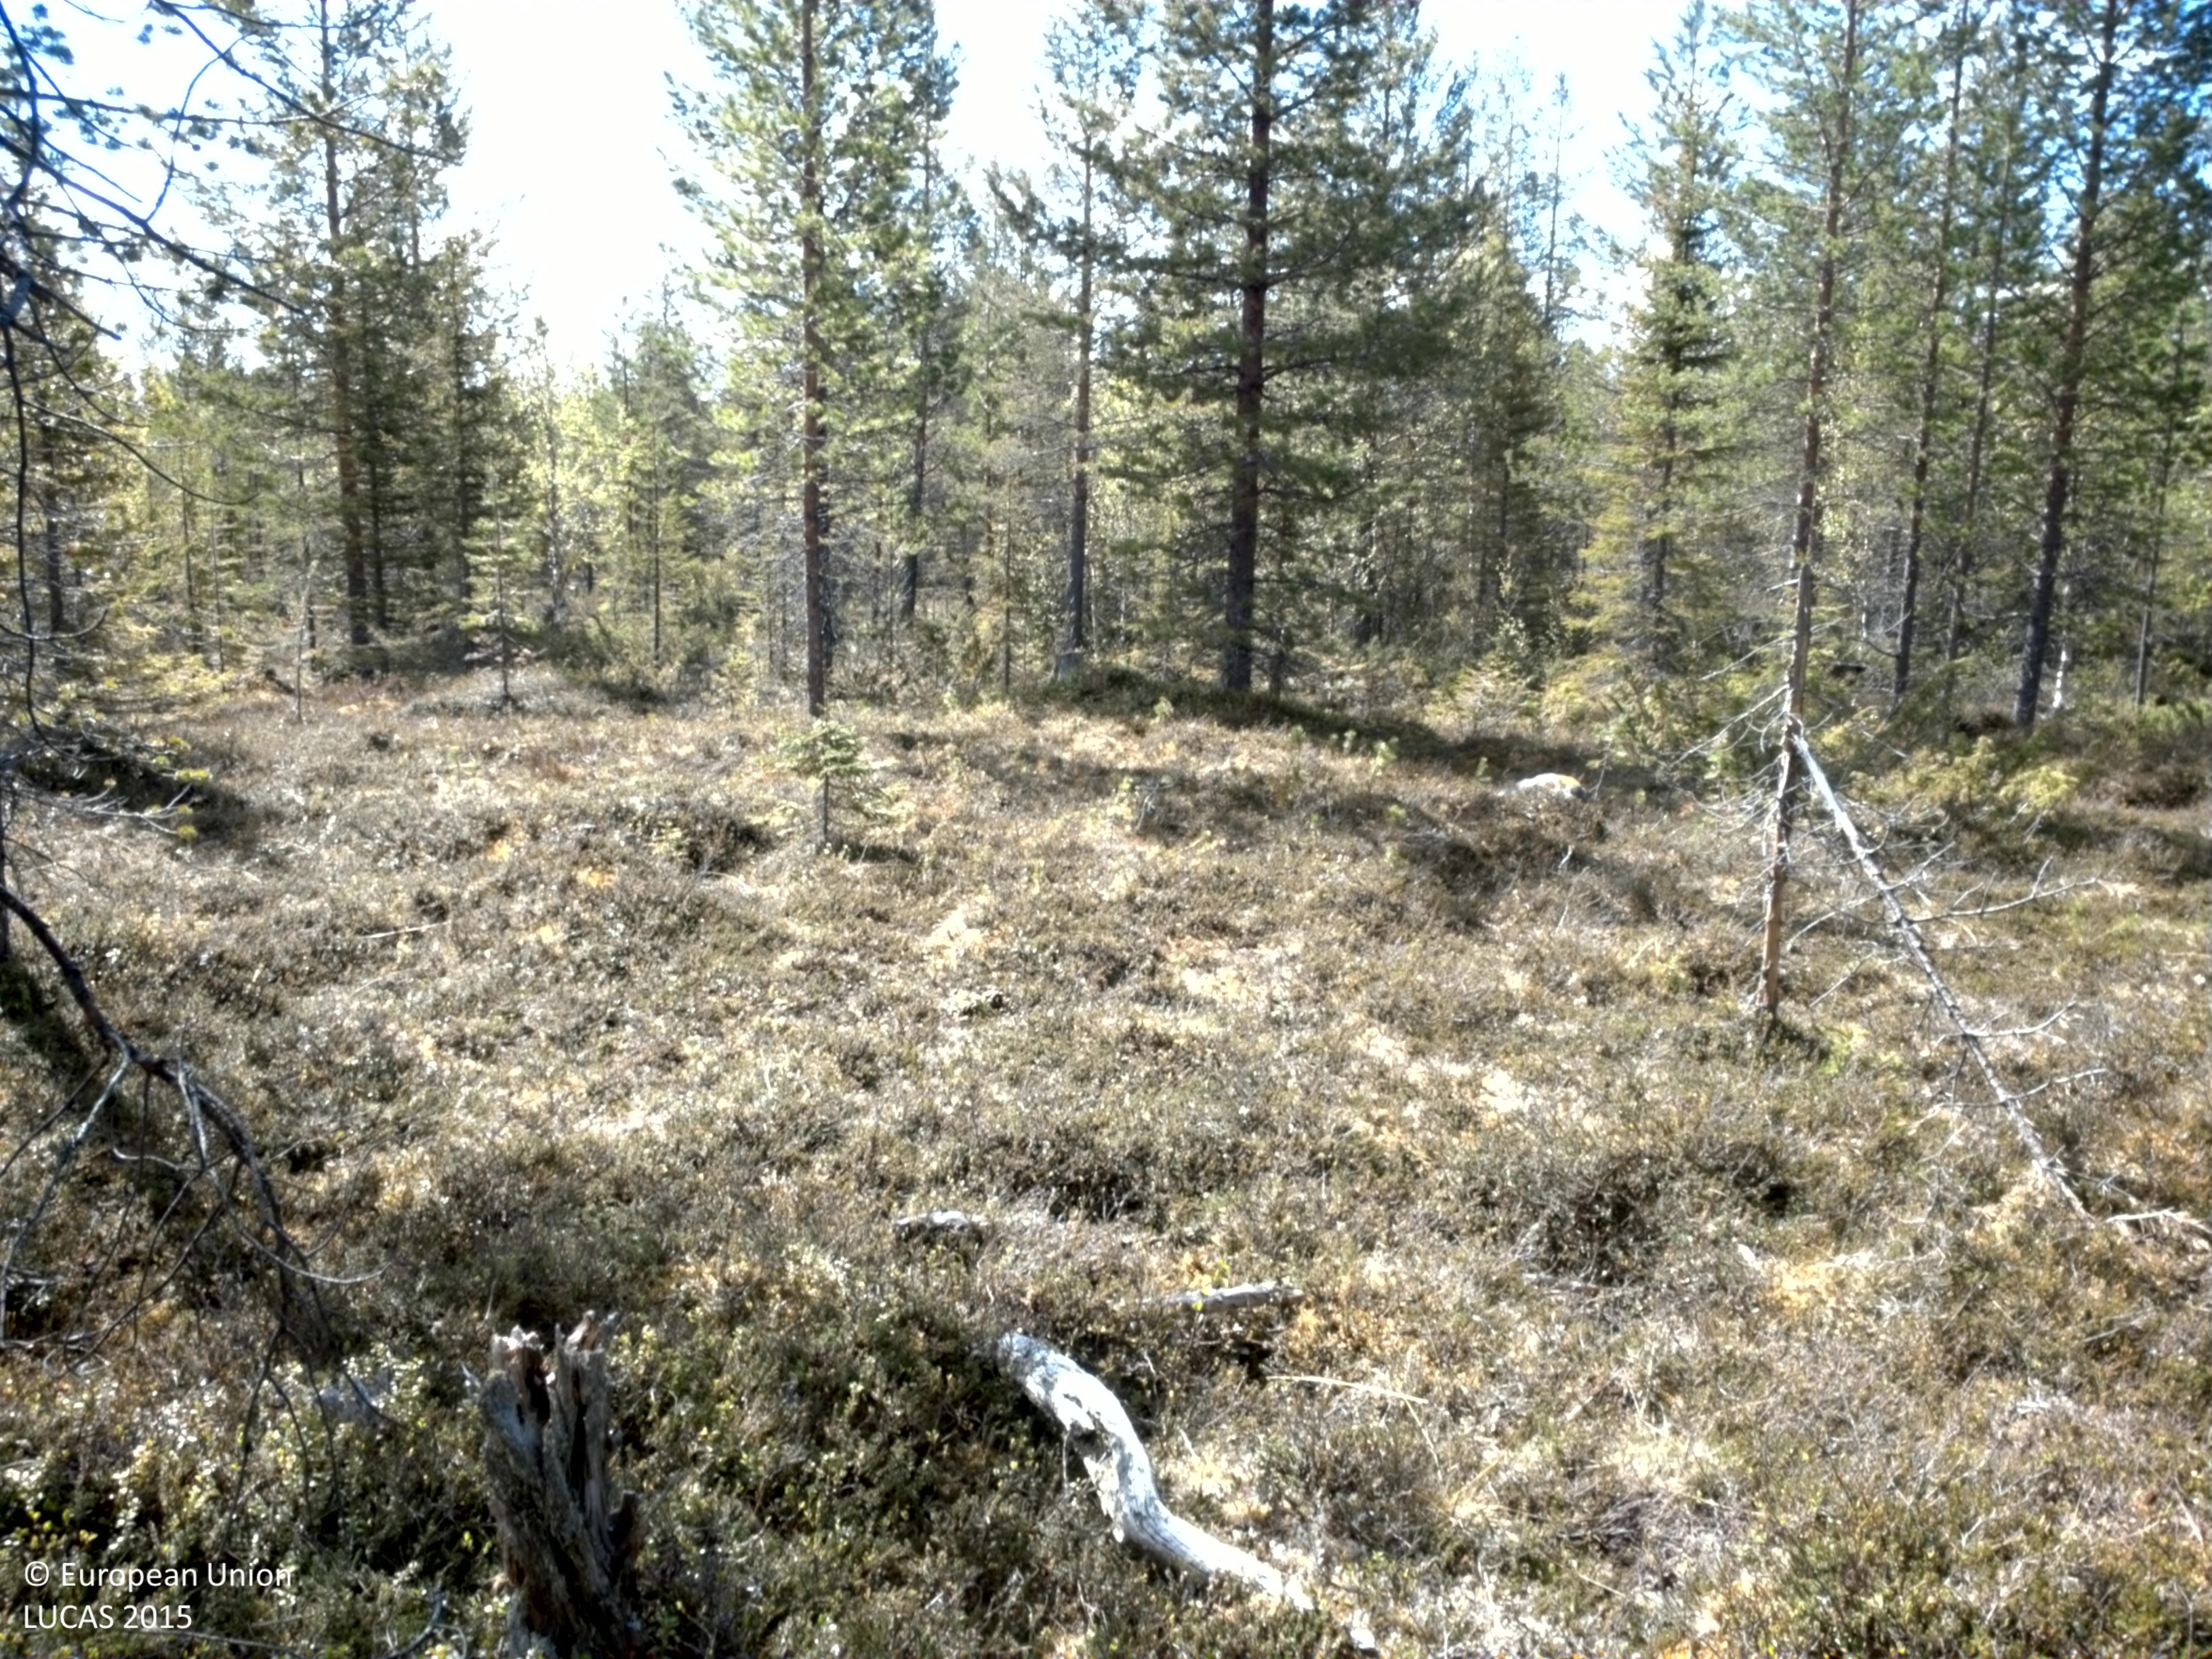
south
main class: Woodland
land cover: Pine dominated coniferous woodland
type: boreal forest
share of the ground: 25 - 50 %
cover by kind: shrubs 55 %, coniferous forest trees 40 %, lichens and mosses 5 %
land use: Forestry
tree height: > 5 m
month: June
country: SE
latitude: 65.9458
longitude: 18.6410
